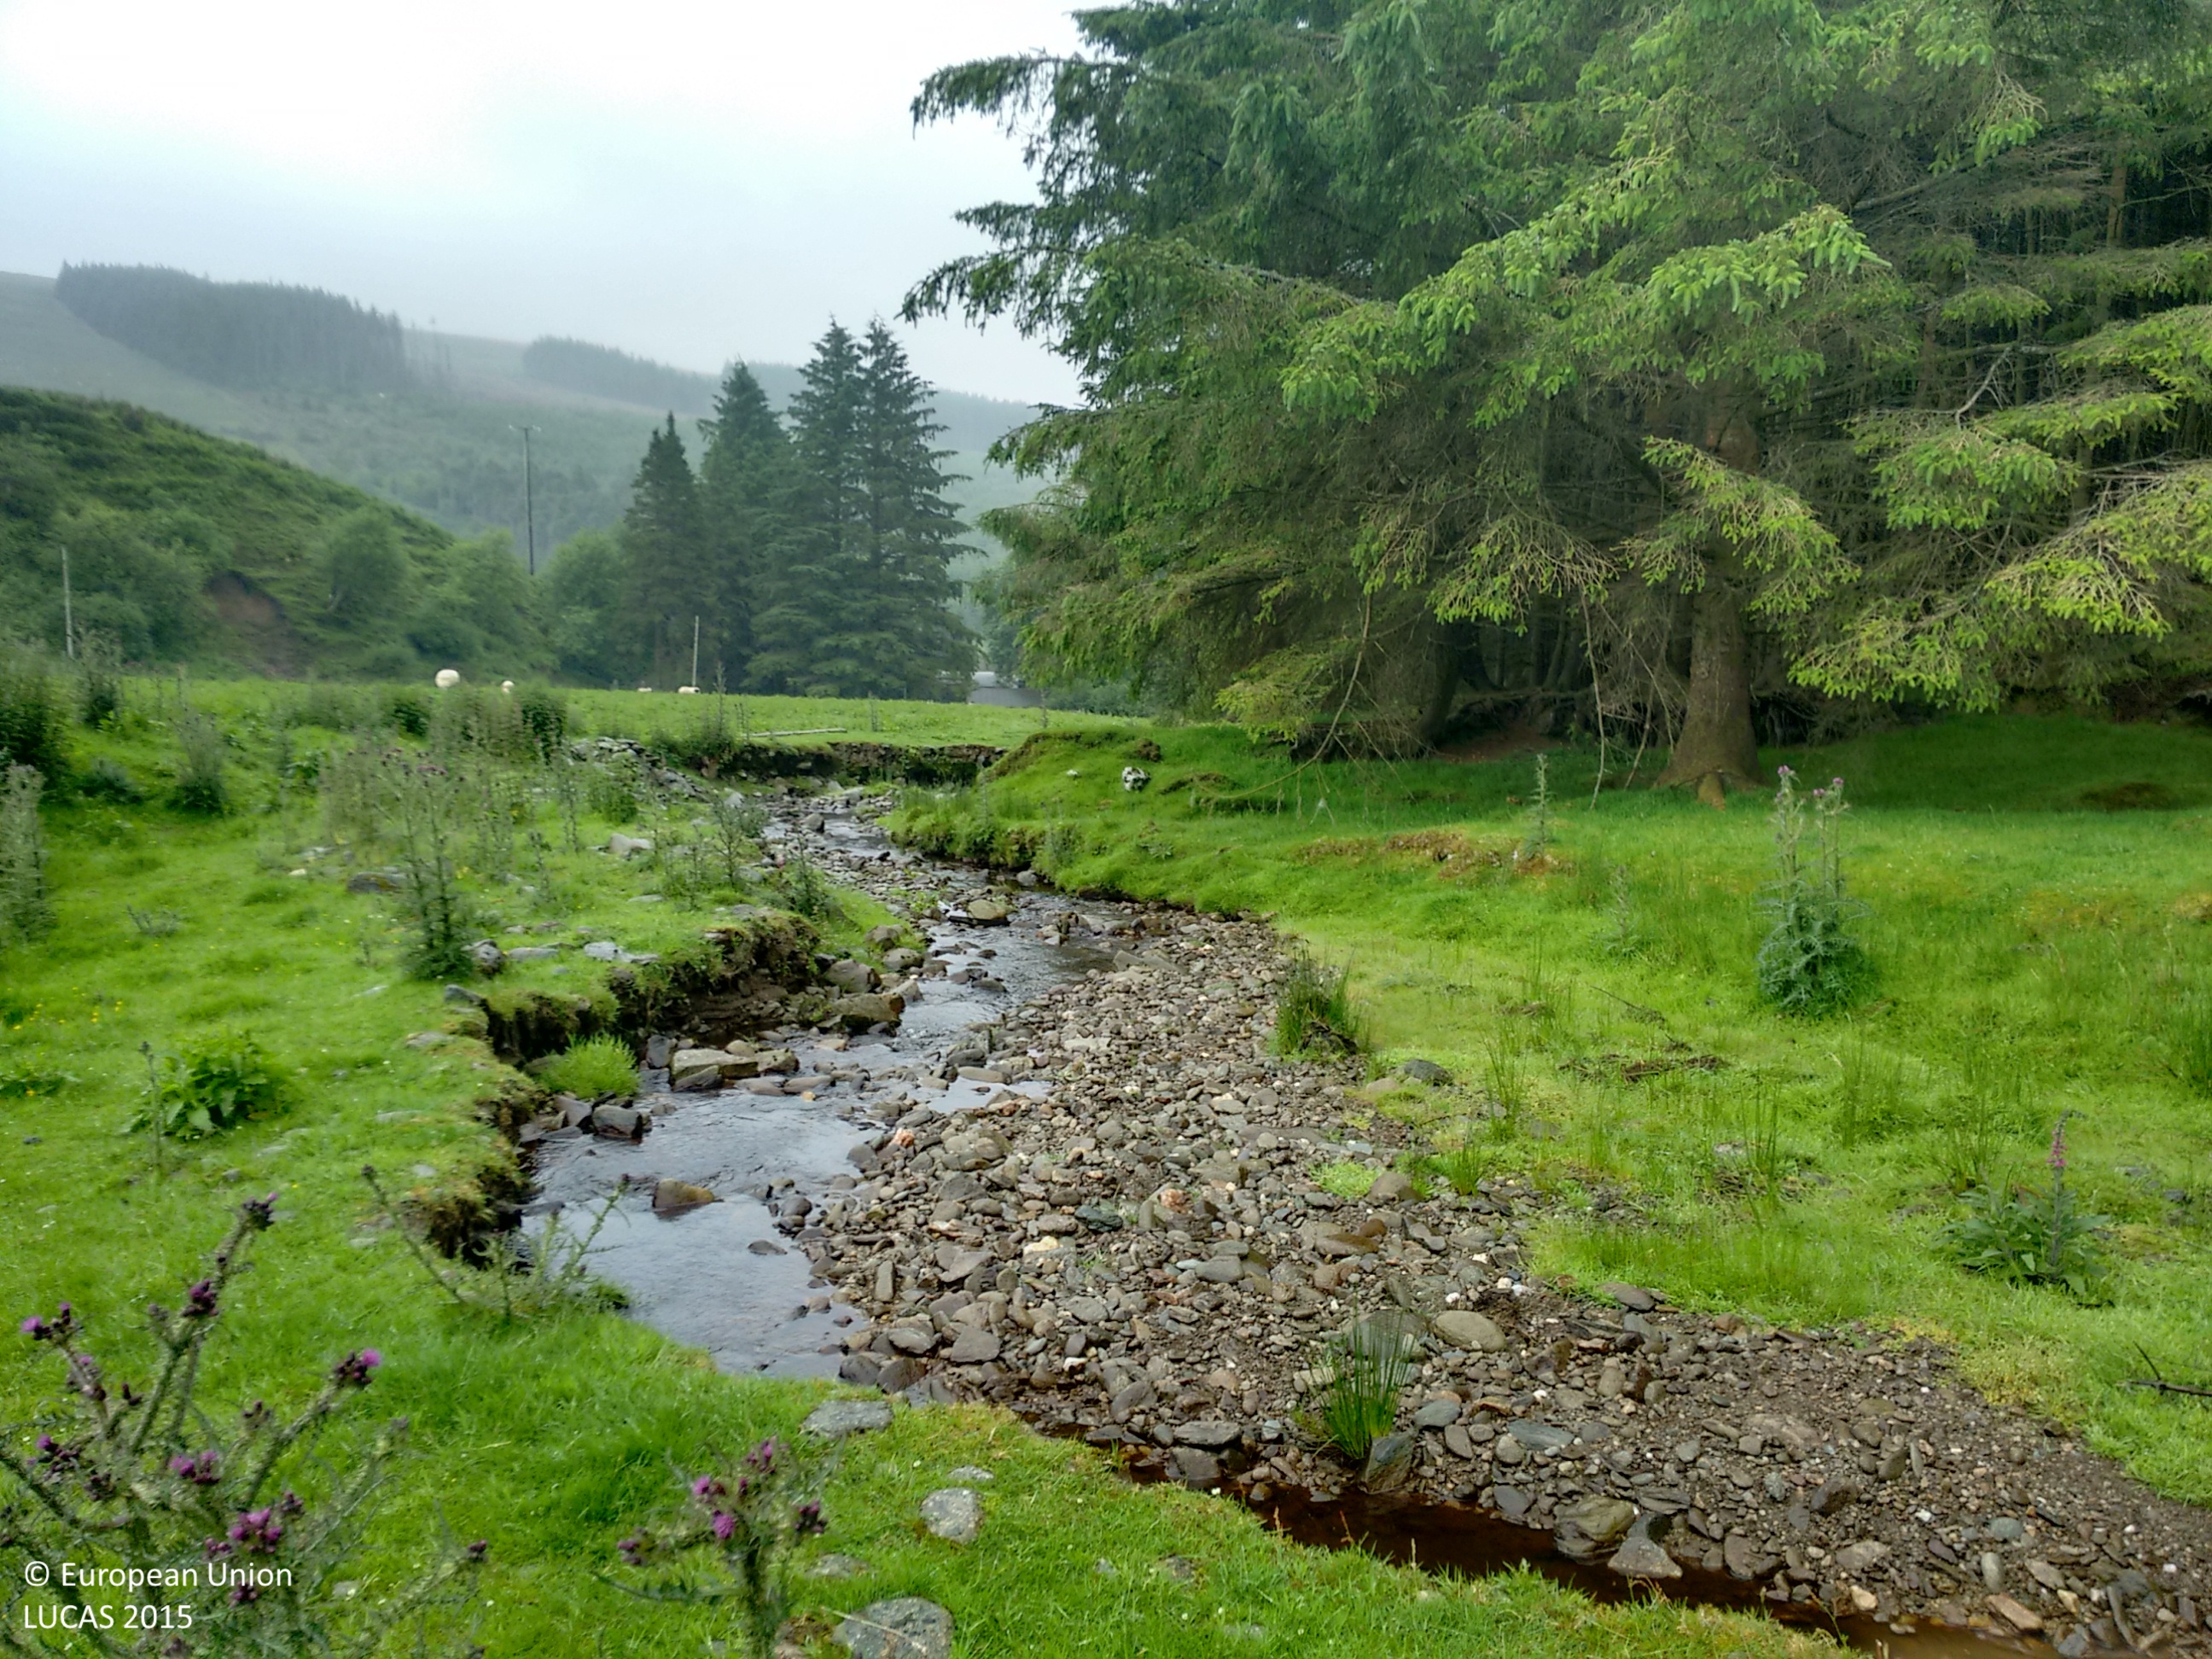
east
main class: Grassland
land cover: Grassland without tree/shrub cover
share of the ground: > 75 %
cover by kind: herbaceous plants 100 %
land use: Agriculture (excluding fallow land and kitchen gardens)
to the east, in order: Grassland without tree/shrub cover; Rock outcrops; Rivers and streams; Rock outcrops; Grass margins; Fences; Spruce dominated coniferous woodland; Grassland without tree/shrub cover; Spruce dominated coniferous woodland
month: July
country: GB
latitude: 54.7897
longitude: -6.9483
